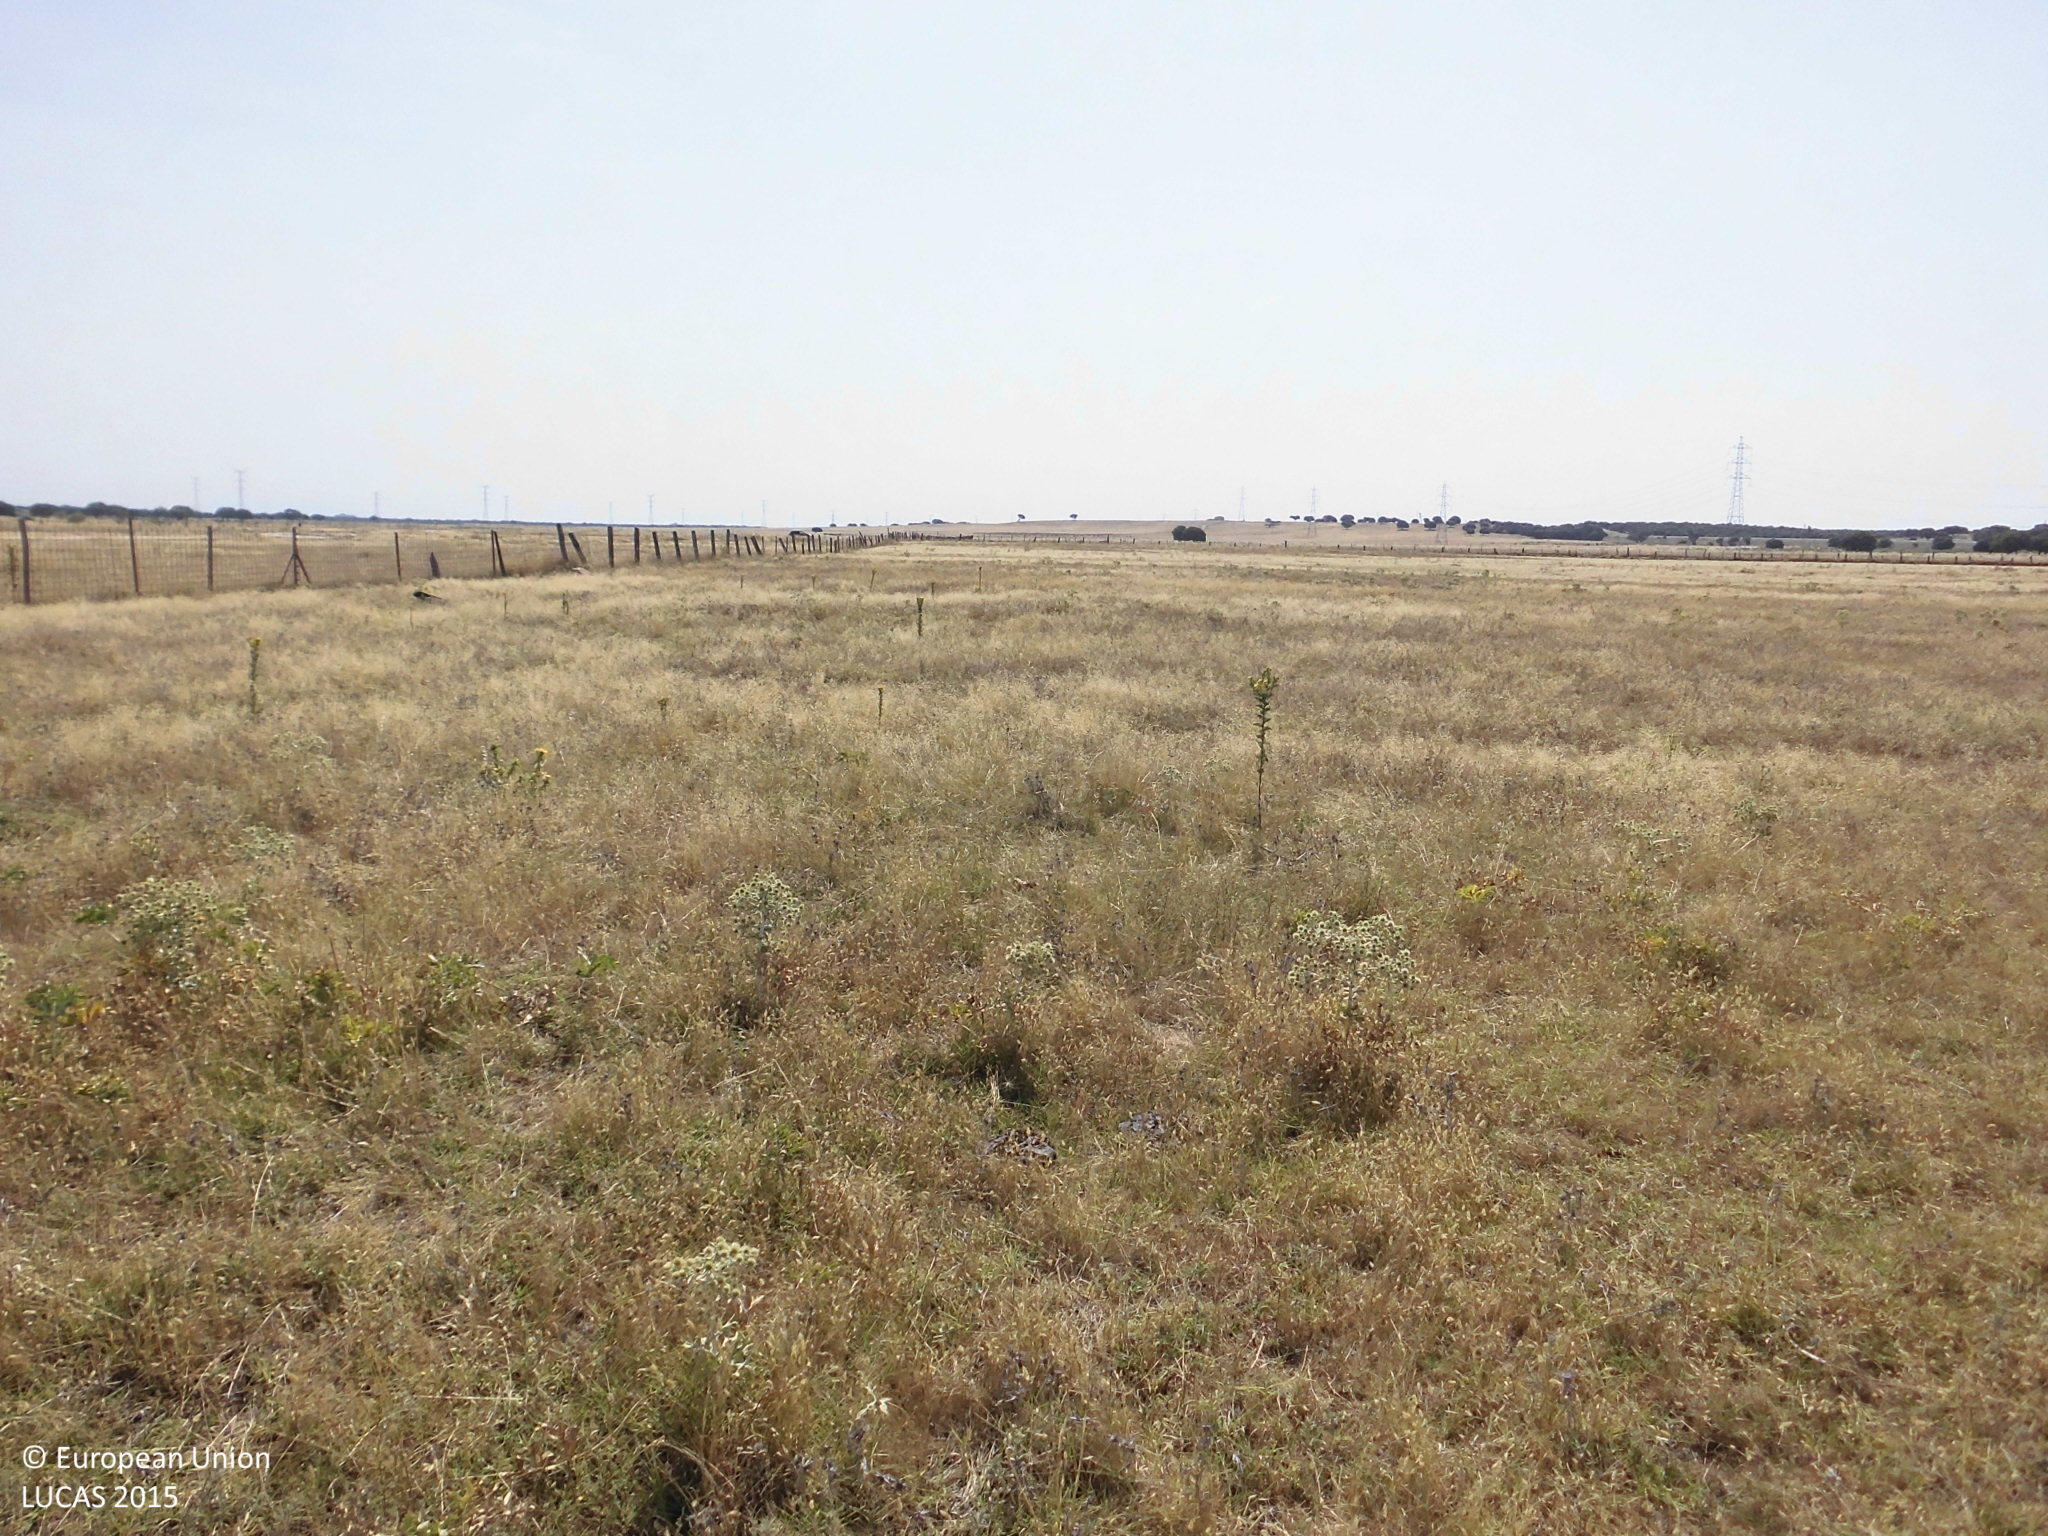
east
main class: Grassland
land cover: Grassland without tree/shrub cover
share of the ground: > 75 %
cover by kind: herbaceous plants 100 %
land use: Agriculture (excluding fallow land and kitchen gardens)
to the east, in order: Grassland without tree/shrub cover
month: July
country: ES
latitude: 39.9151
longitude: -5.4652
